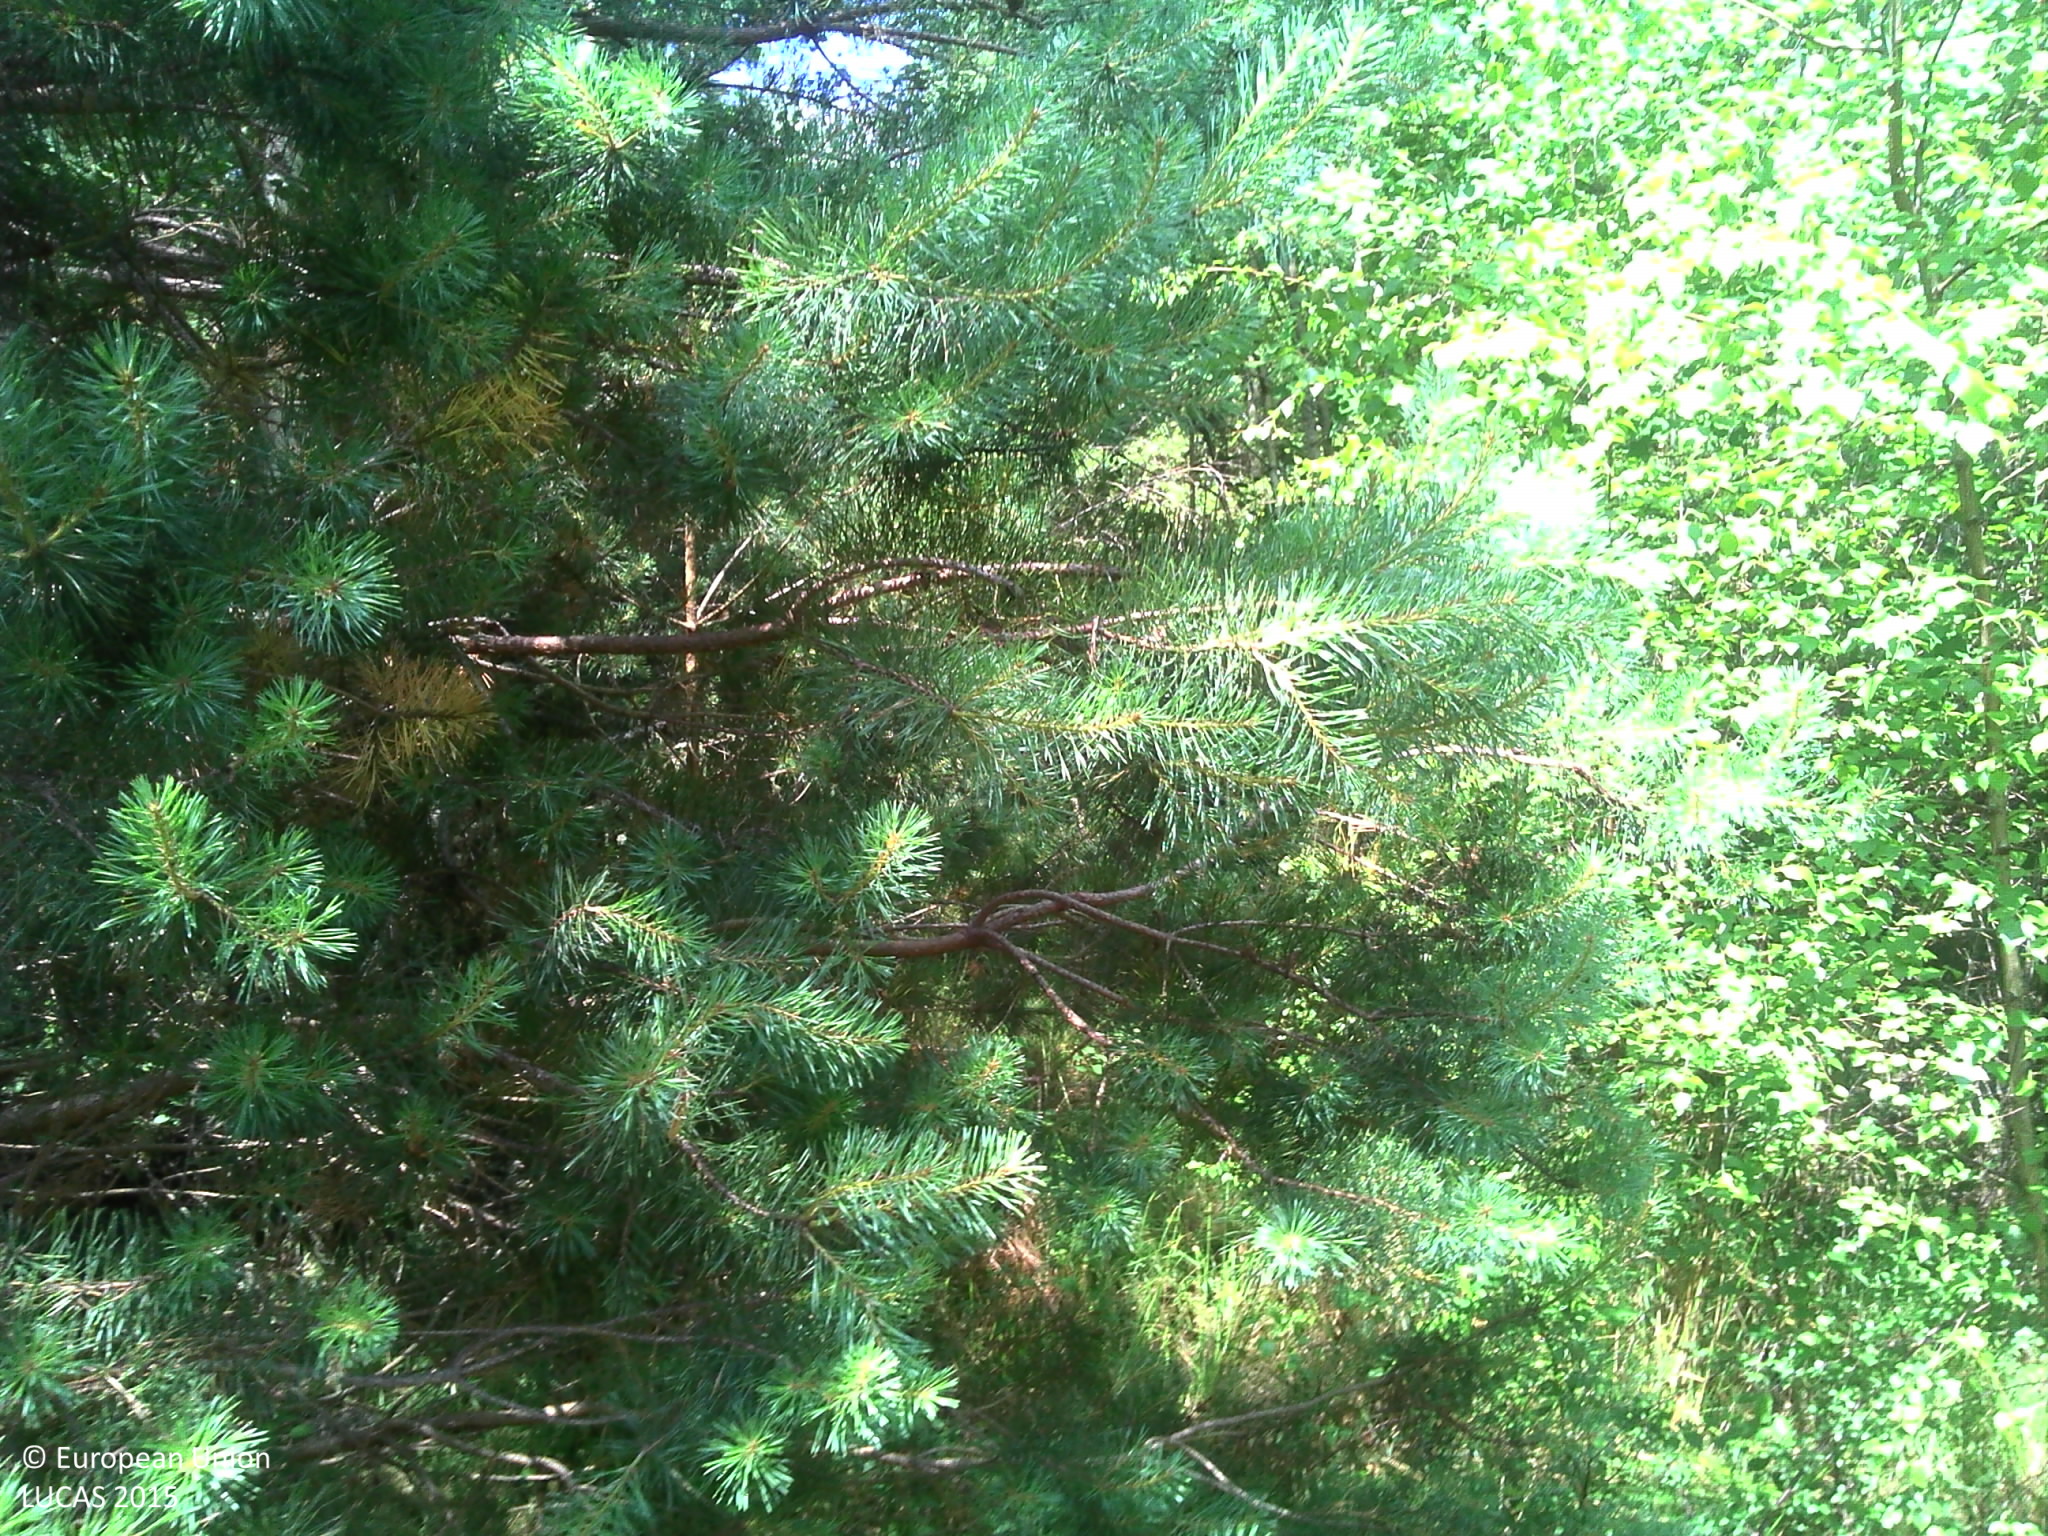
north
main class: Woodland
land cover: Pine dominated mixed woodland
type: thermophilous deciduous forest
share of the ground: > 75 %
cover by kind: coniferous forest trees 30 %, broadleaved forest trees 30 %, herbaceous plants 20 %, unconsolidated bare surface 20 %
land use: Forestry
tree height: > 5 m
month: June
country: FR
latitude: 47.6622
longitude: 2.0124
